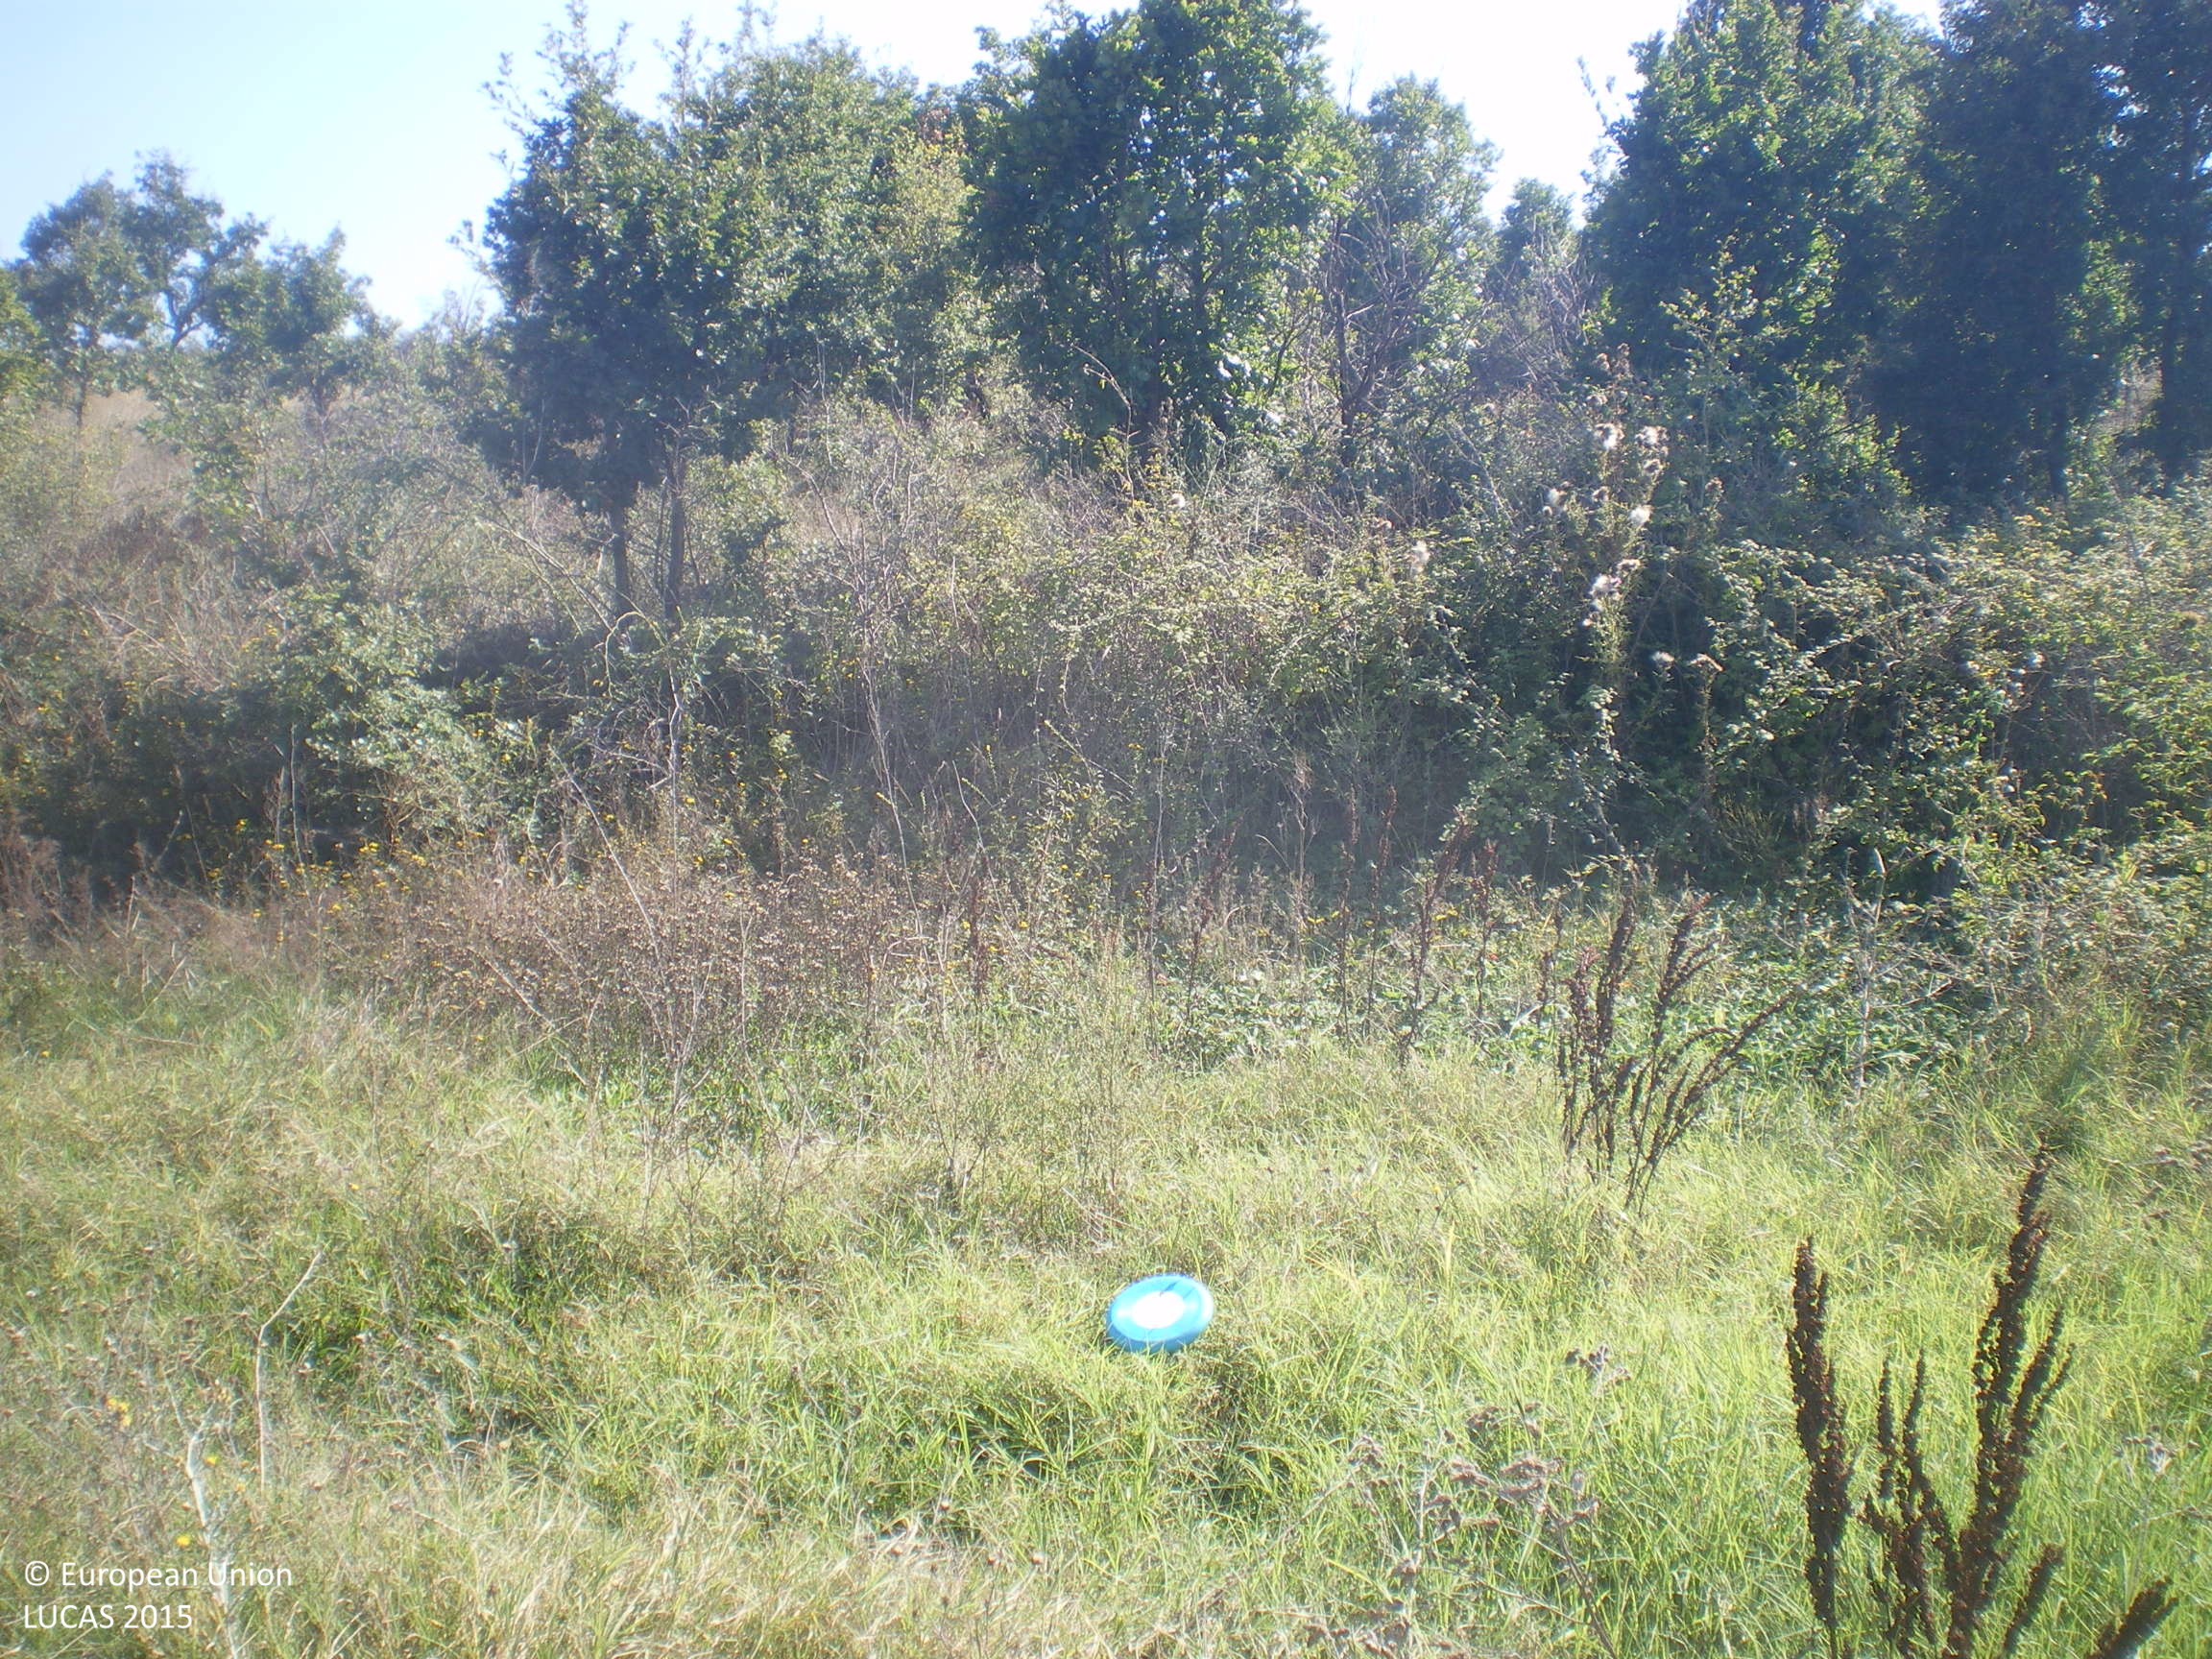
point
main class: Grassland
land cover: Grassland with sparse tree/shrub cover
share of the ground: > 75 %
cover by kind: herbaceous plants 85 %, shrubs 10 %, broadleaved forest trees 5 %
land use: Agriculture (excluding fallow land and kitchen gardens)
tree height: > 5 m
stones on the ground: < 10 %
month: September
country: BG
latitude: 41.8453
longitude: 26.0309
